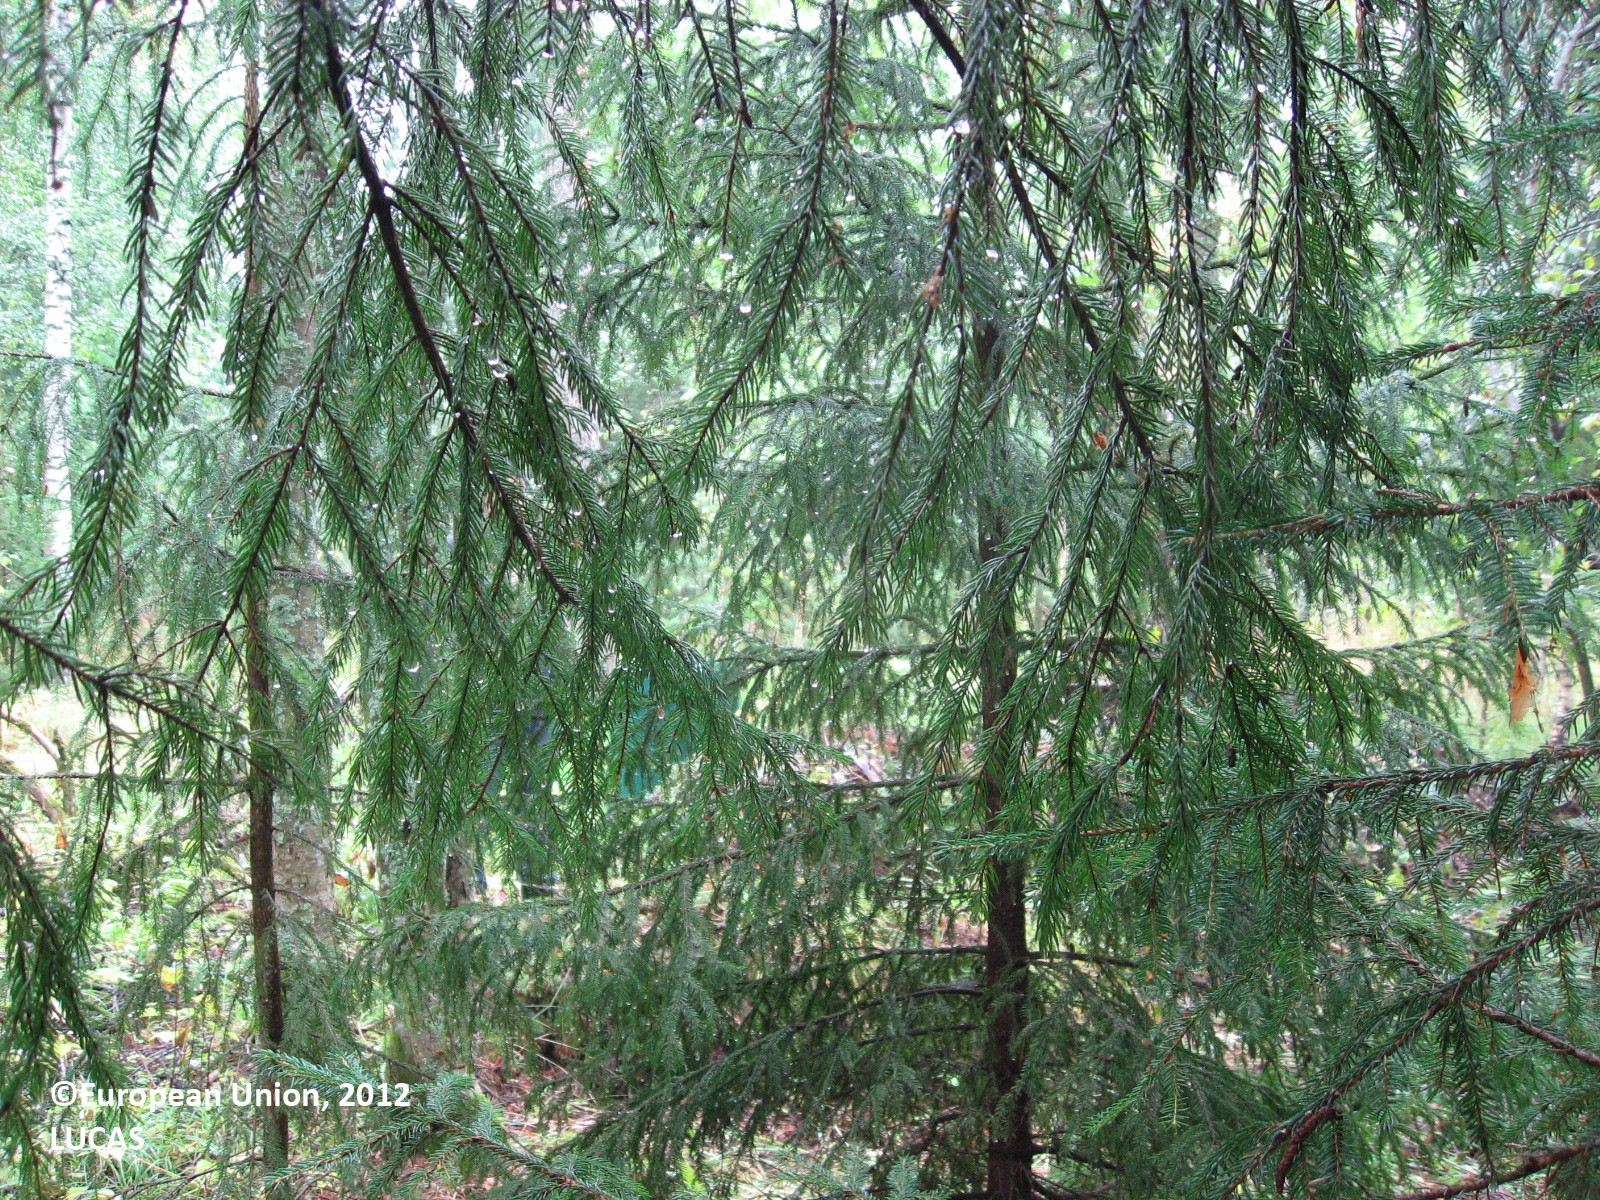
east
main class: Woodland
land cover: Spruce dominated mixed woodland
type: boreal forest
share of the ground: > 75 %
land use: Forestry
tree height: > 5 m
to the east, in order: Spruce dominated mixed woodland; Artificial constructions in urban areas; Spruce dominated coniferous woodland; Ditches and canals; Grass margins; Paved roads, cycling and walking lanes; Grass margins; Spruce dominated mixed woodland; Rivers and streams; Spruce dominated mixed woodland; Grass margins; Arable land (only in case pi)
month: August
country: FI
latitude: 60.5993
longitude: 25.0370
